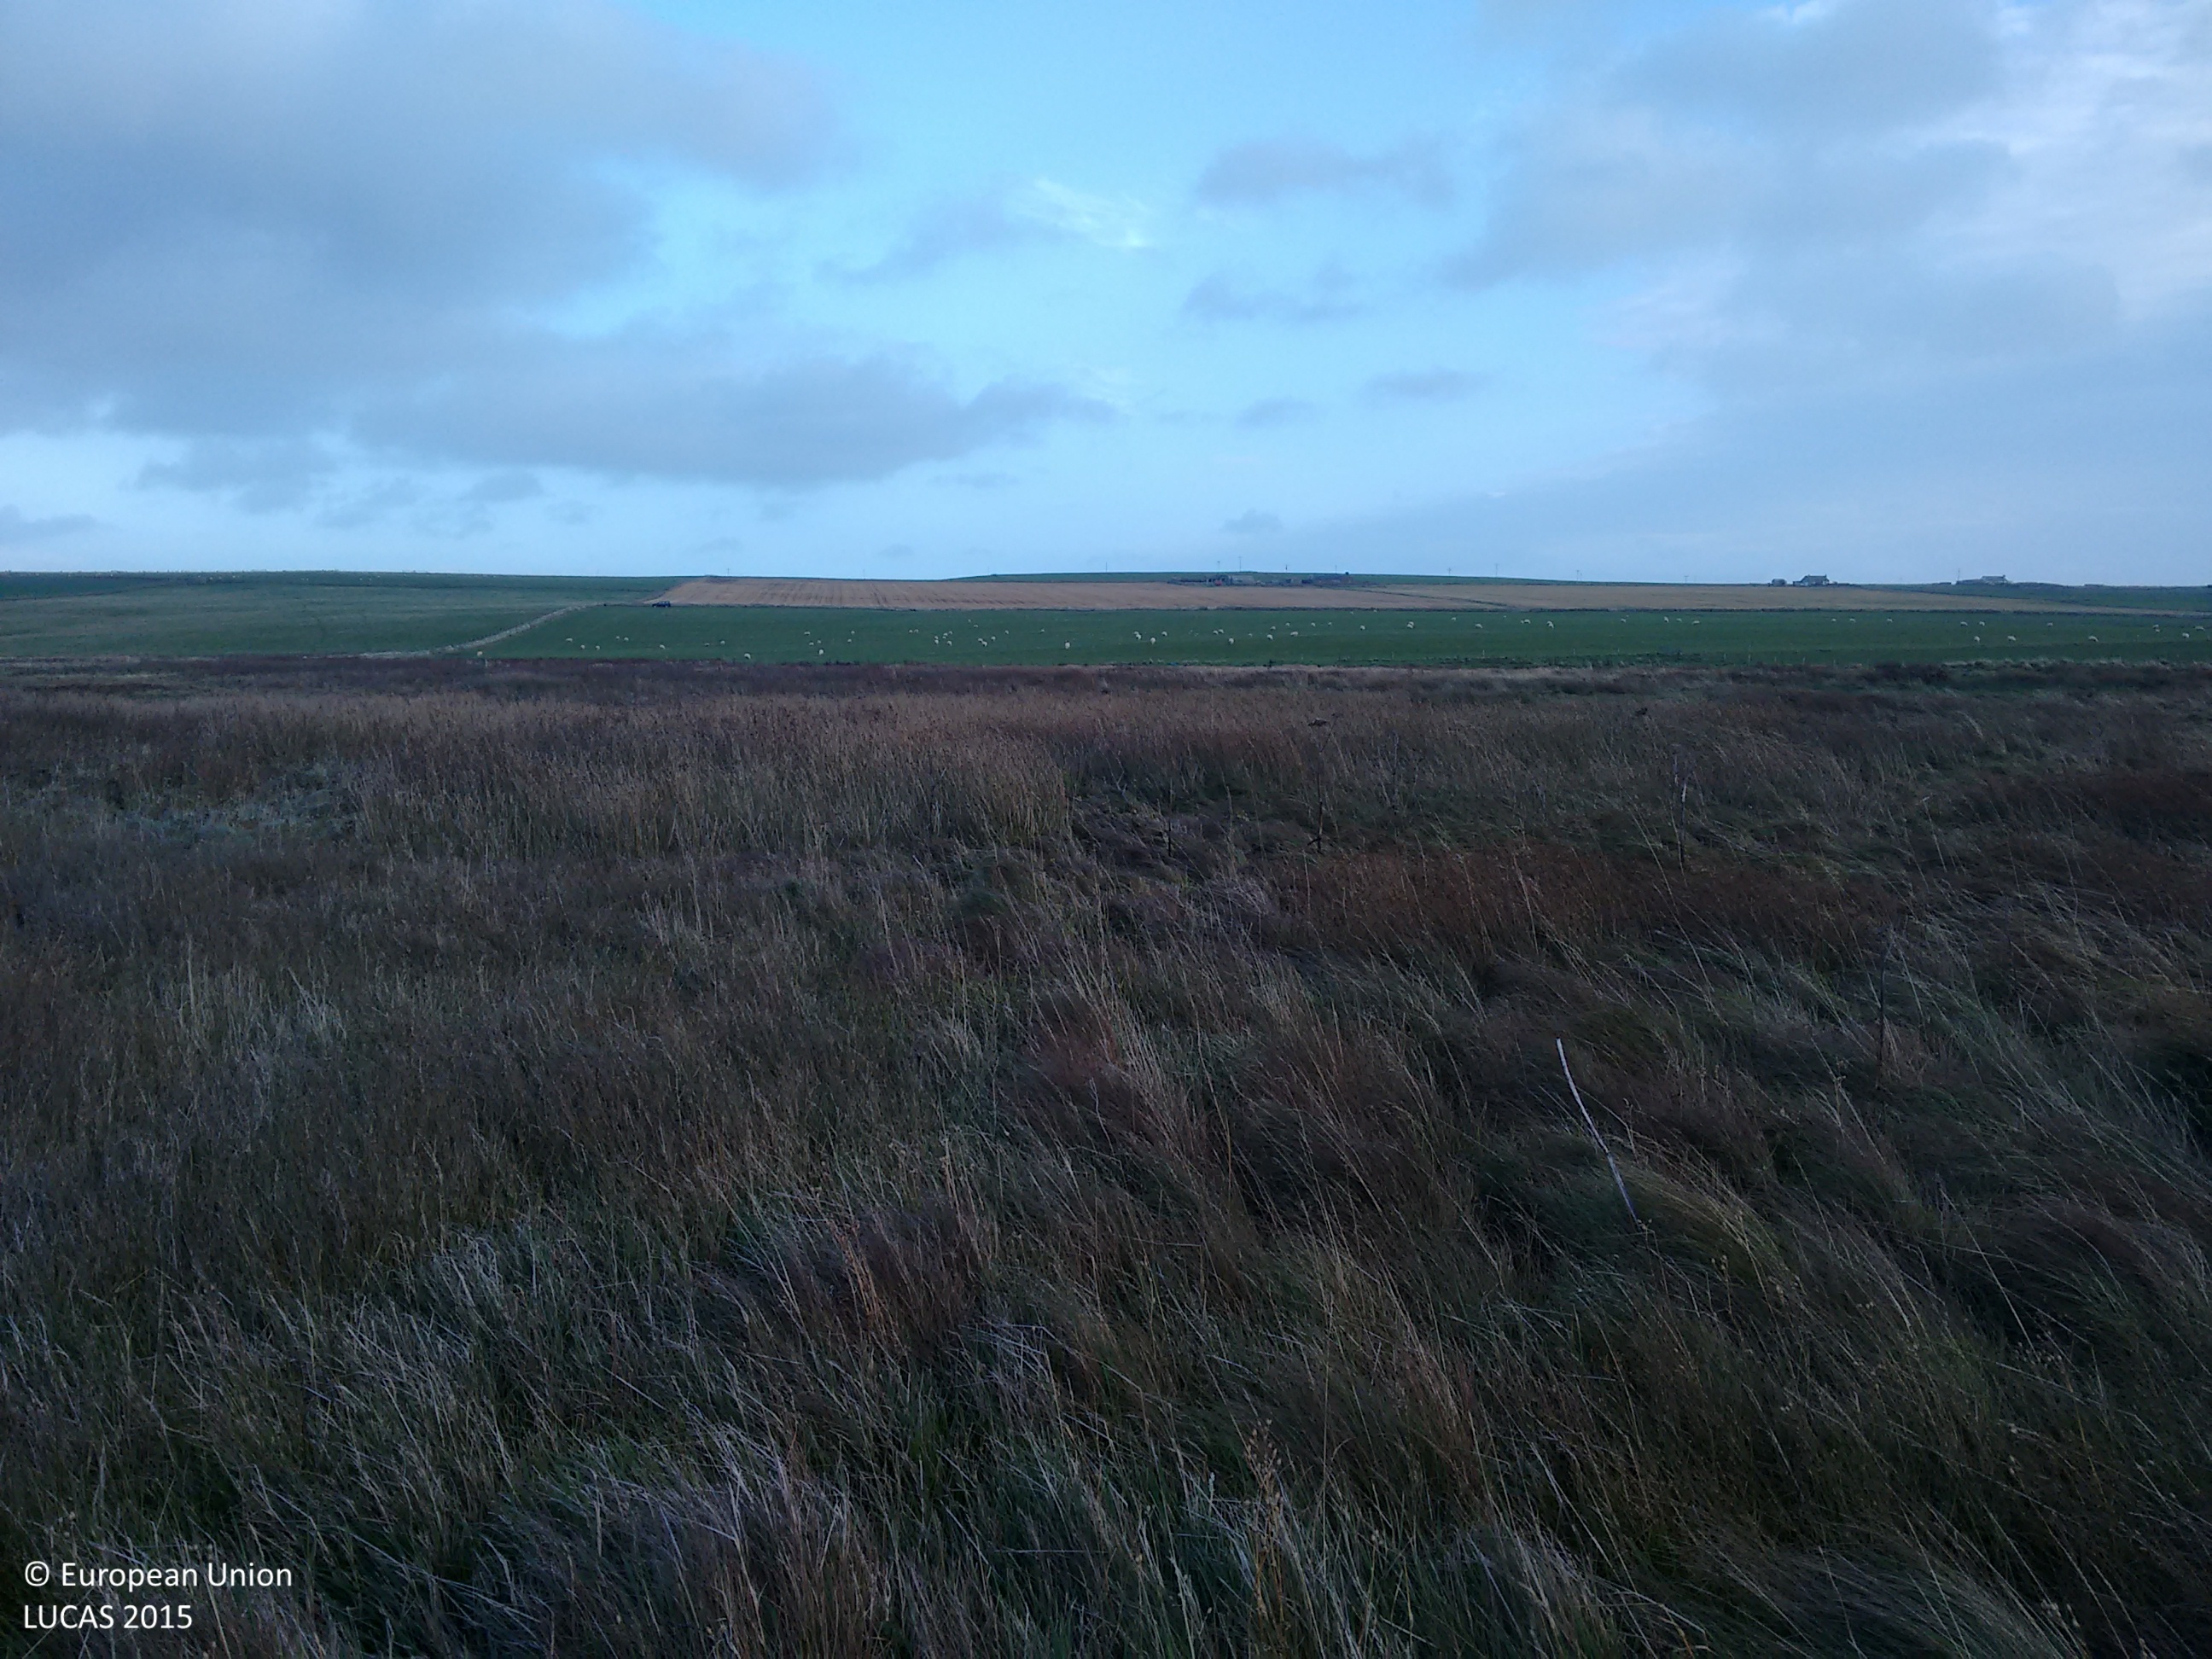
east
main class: Grassland
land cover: Grassland without tree/shrub cover
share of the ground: > 75 %
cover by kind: herbaceous plants 100 %
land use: Agriculture (excluding fallow land and kitchen gardens)
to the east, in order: Grassland without tree/shrub cover; Inland marshes; Grassland without tree/shrub cover; Fences; Grassland without tree/shrub cover
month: November
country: GB
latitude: 58.9381
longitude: -2.7860
